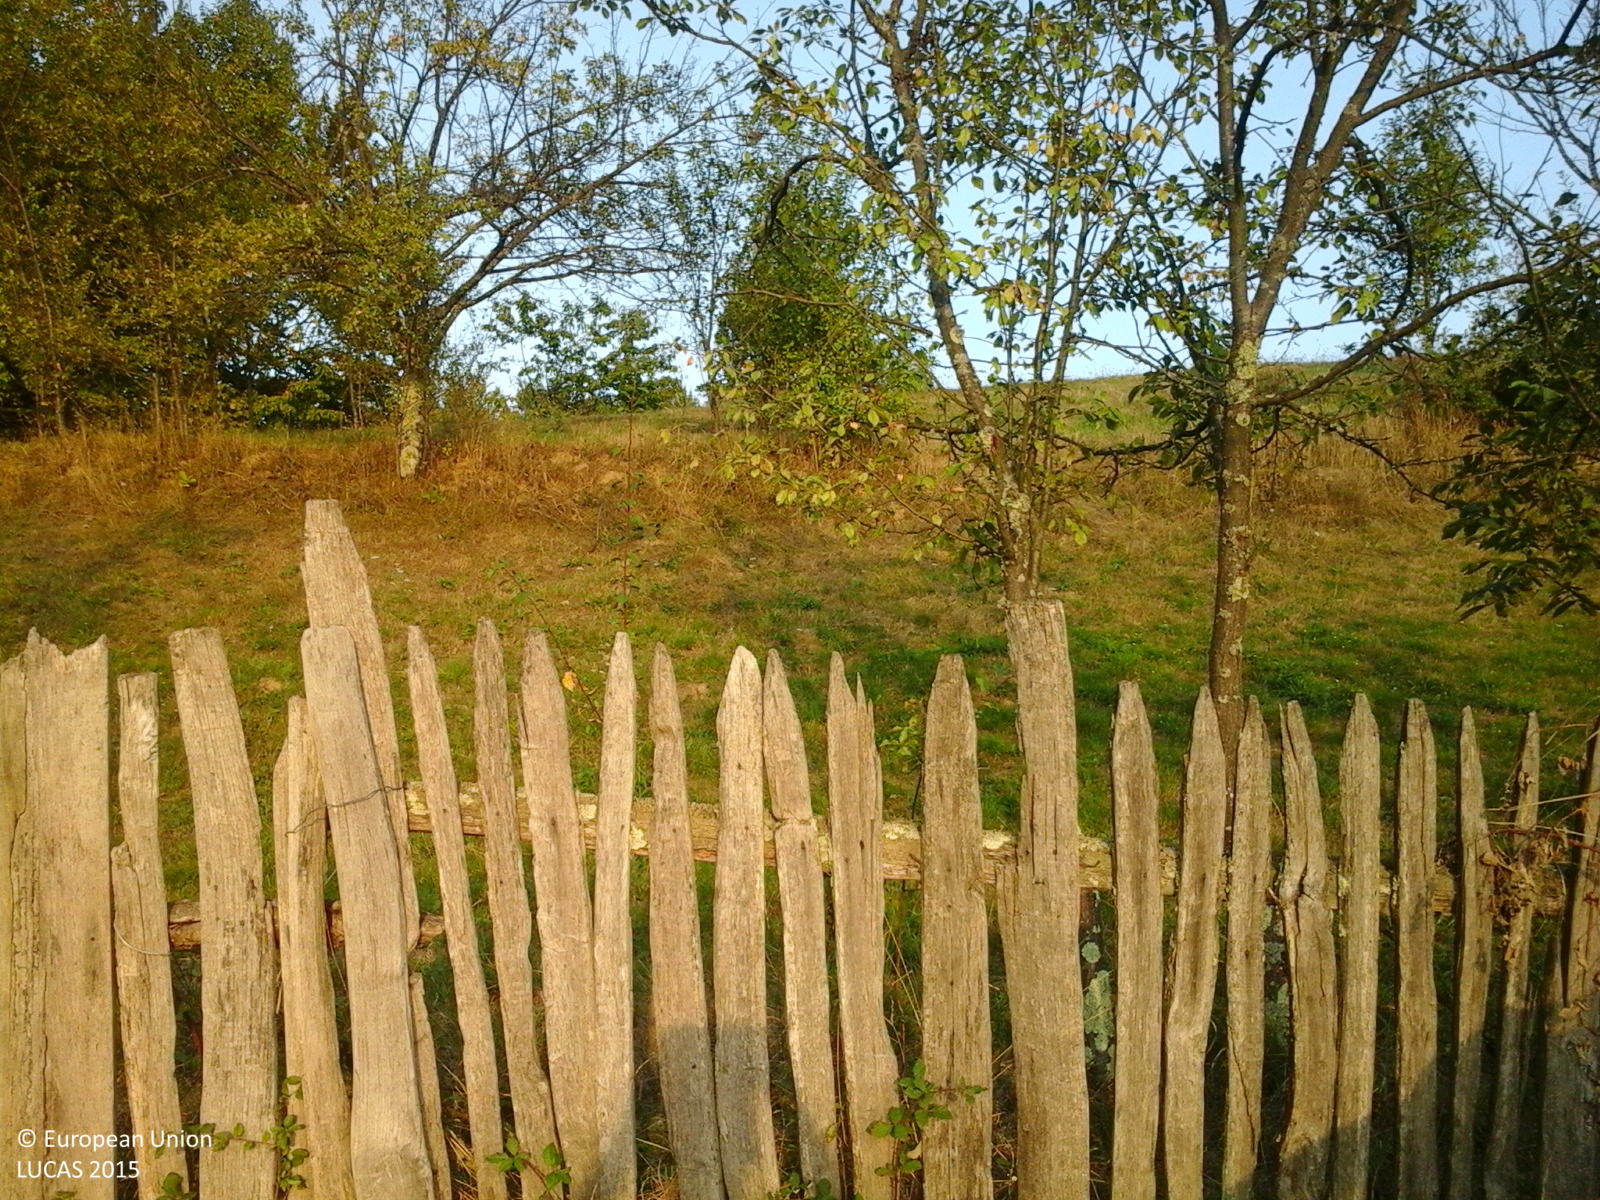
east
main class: Grassland
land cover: Grassland with sparse tree/shrub cover
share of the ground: > 75 %
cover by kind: herbaceous plants 85 %, shrubs 10 %, broadleaved forest trees 5 %
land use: Agriculture (excluding fallow land and kitchen gardens)
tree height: > 5 m
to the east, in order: Grassland with sparse tree/shrub cover; Tracks; Grass margins; Fences; Other fruit trees and berries; Abandoned hedges; Grass margins; Tracks; Broadleaved woodland
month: September
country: RO
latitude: 46.7530
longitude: 22.4228
